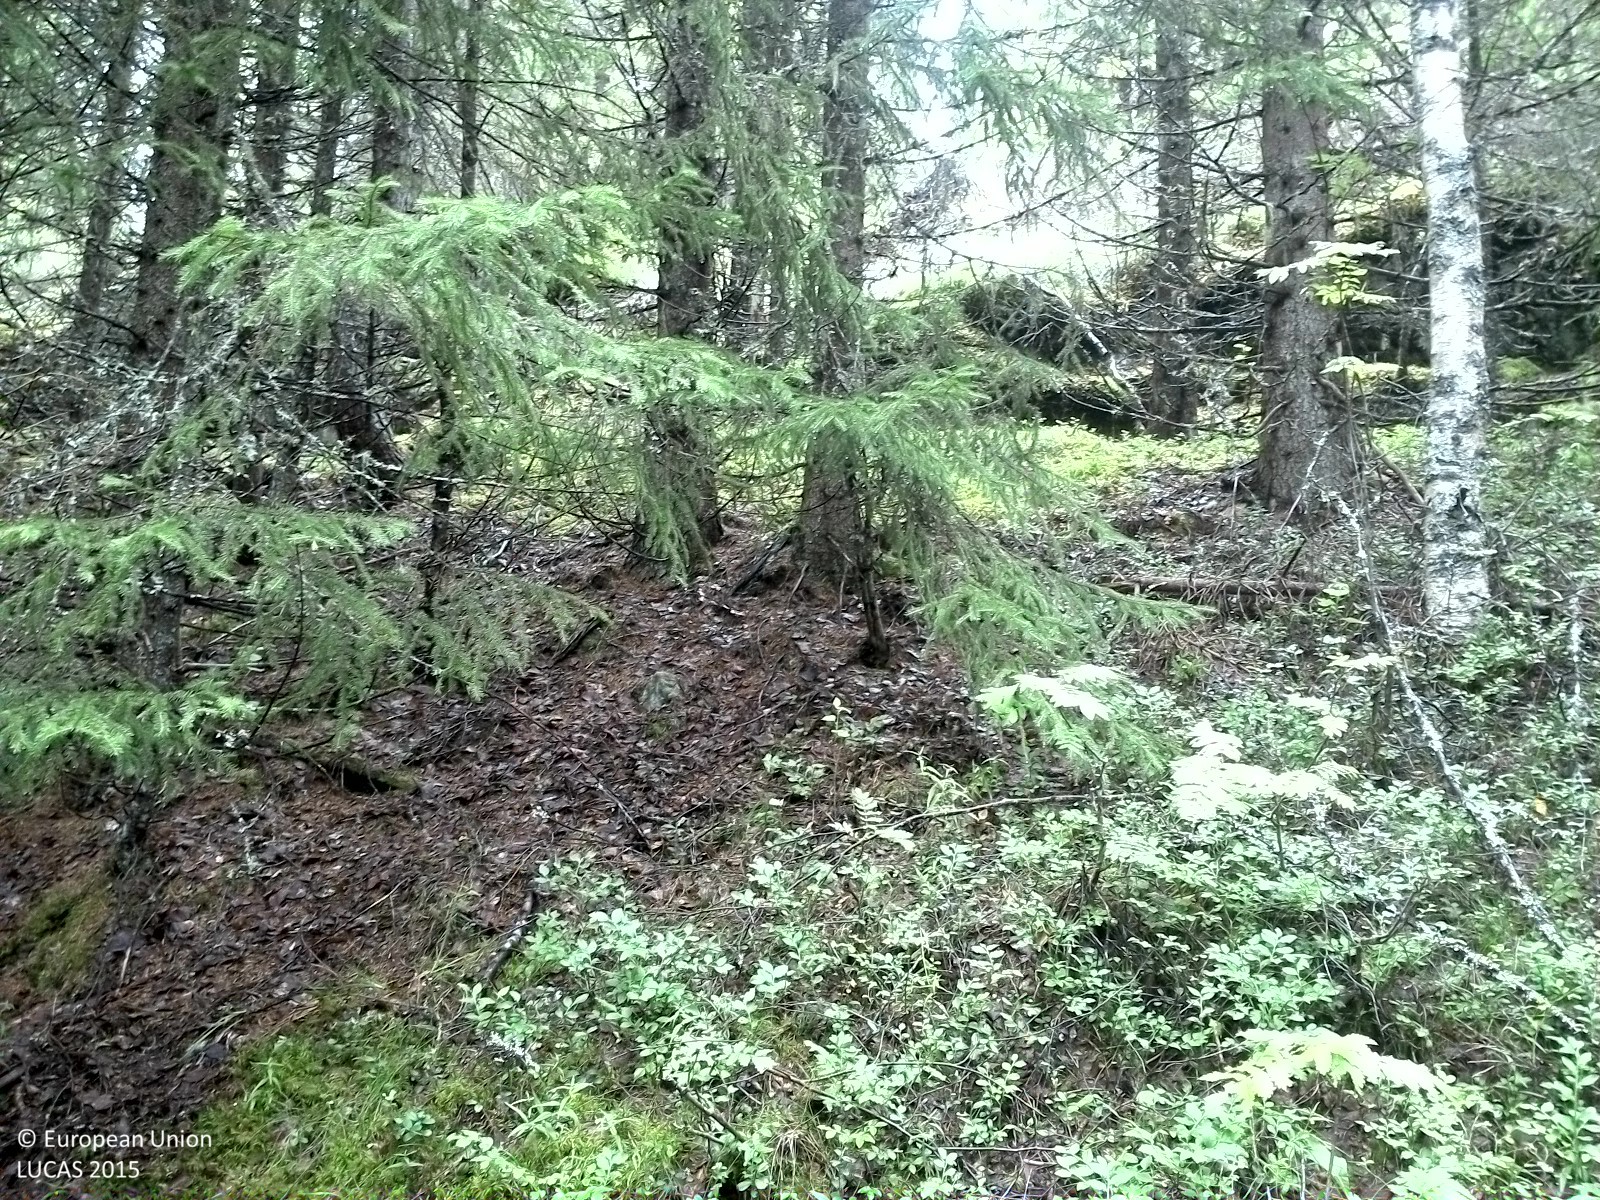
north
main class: Woodland
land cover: Spruce dominated coniferous woodland
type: boreal forest
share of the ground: 50 - 75 %
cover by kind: coniferous forest trees 60 %, shrubs 15 %, lichens and mosses 15 %, broadleaved forest trees 10 %
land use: Forestry
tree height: > 5 m
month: August
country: SE
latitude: 62.6566
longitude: 16.8282
